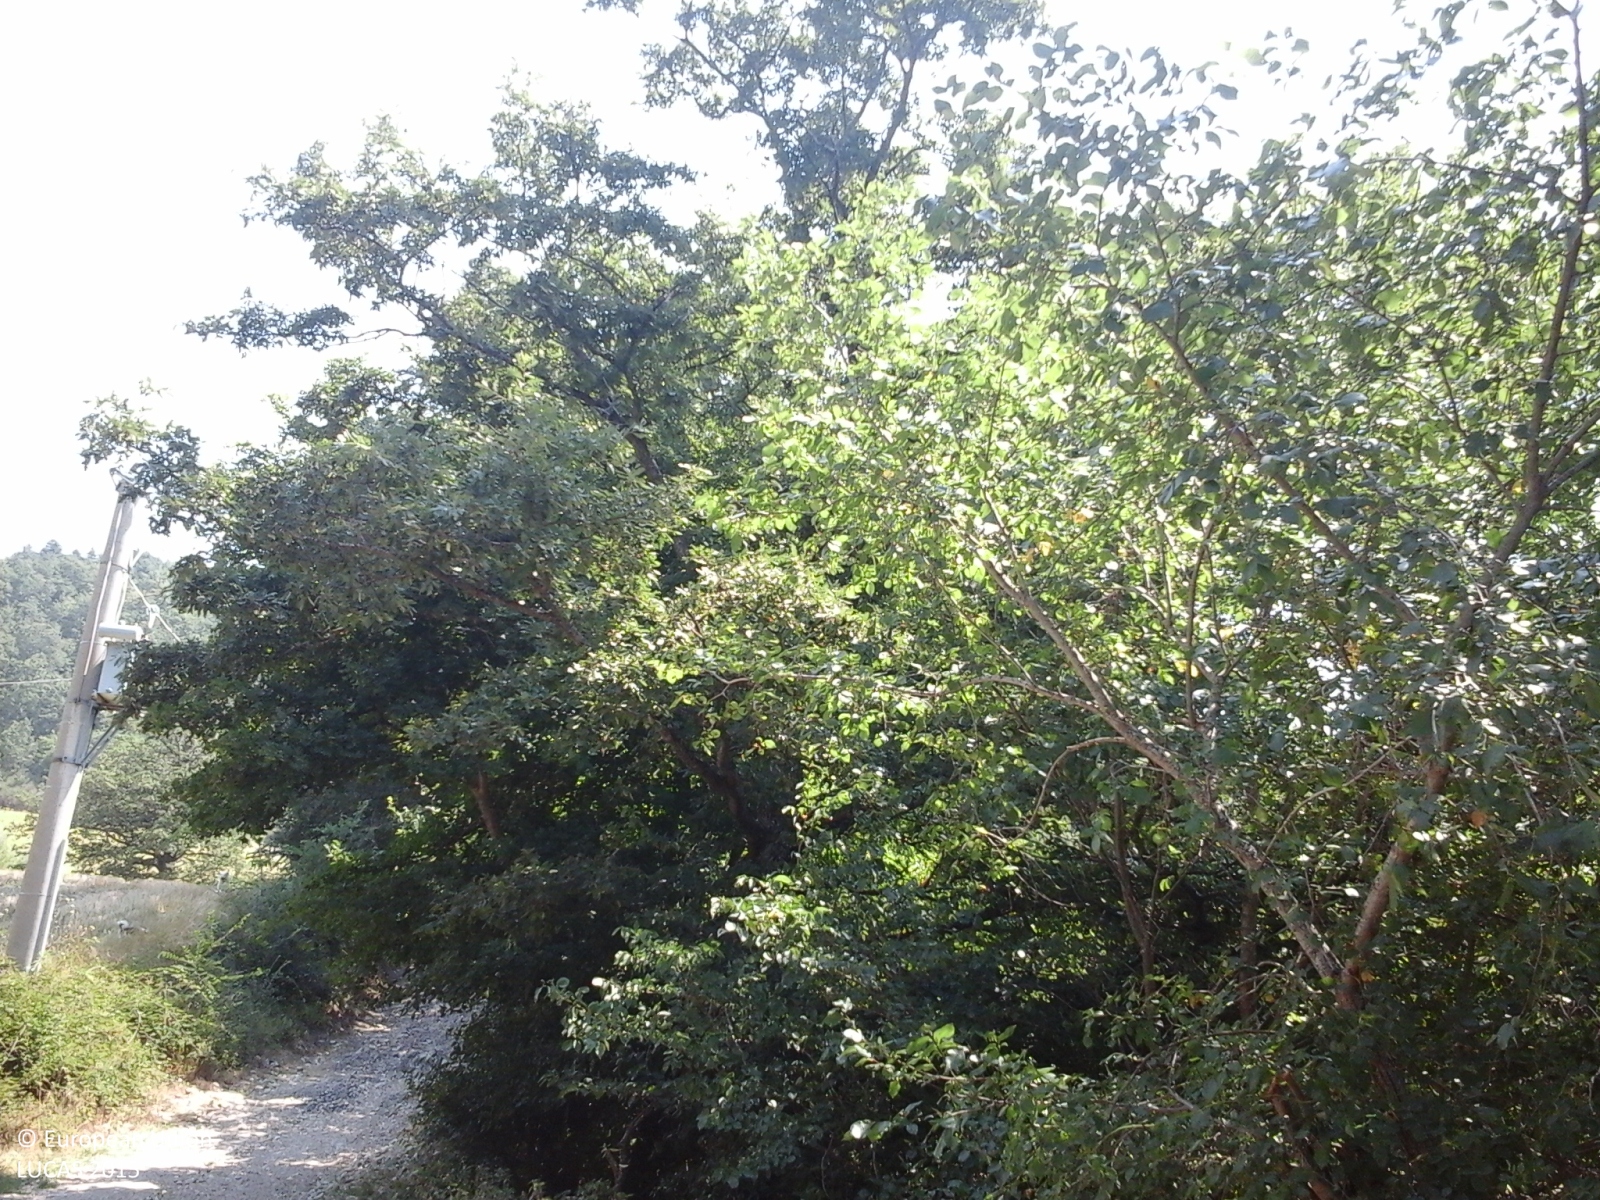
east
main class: Cropland
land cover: Durum wheat
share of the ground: > 75 %
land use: Agriculture (excluding fallow land and kitchen gardens)
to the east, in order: Durum wheat; Electric lines; Durum wheat; Tracks; Abandoned hedges; Ditches and canals; Abandoned hedges; Sunflower; Broadleaved woodland
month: August
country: IT
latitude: 41.3460
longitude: 15.1569
